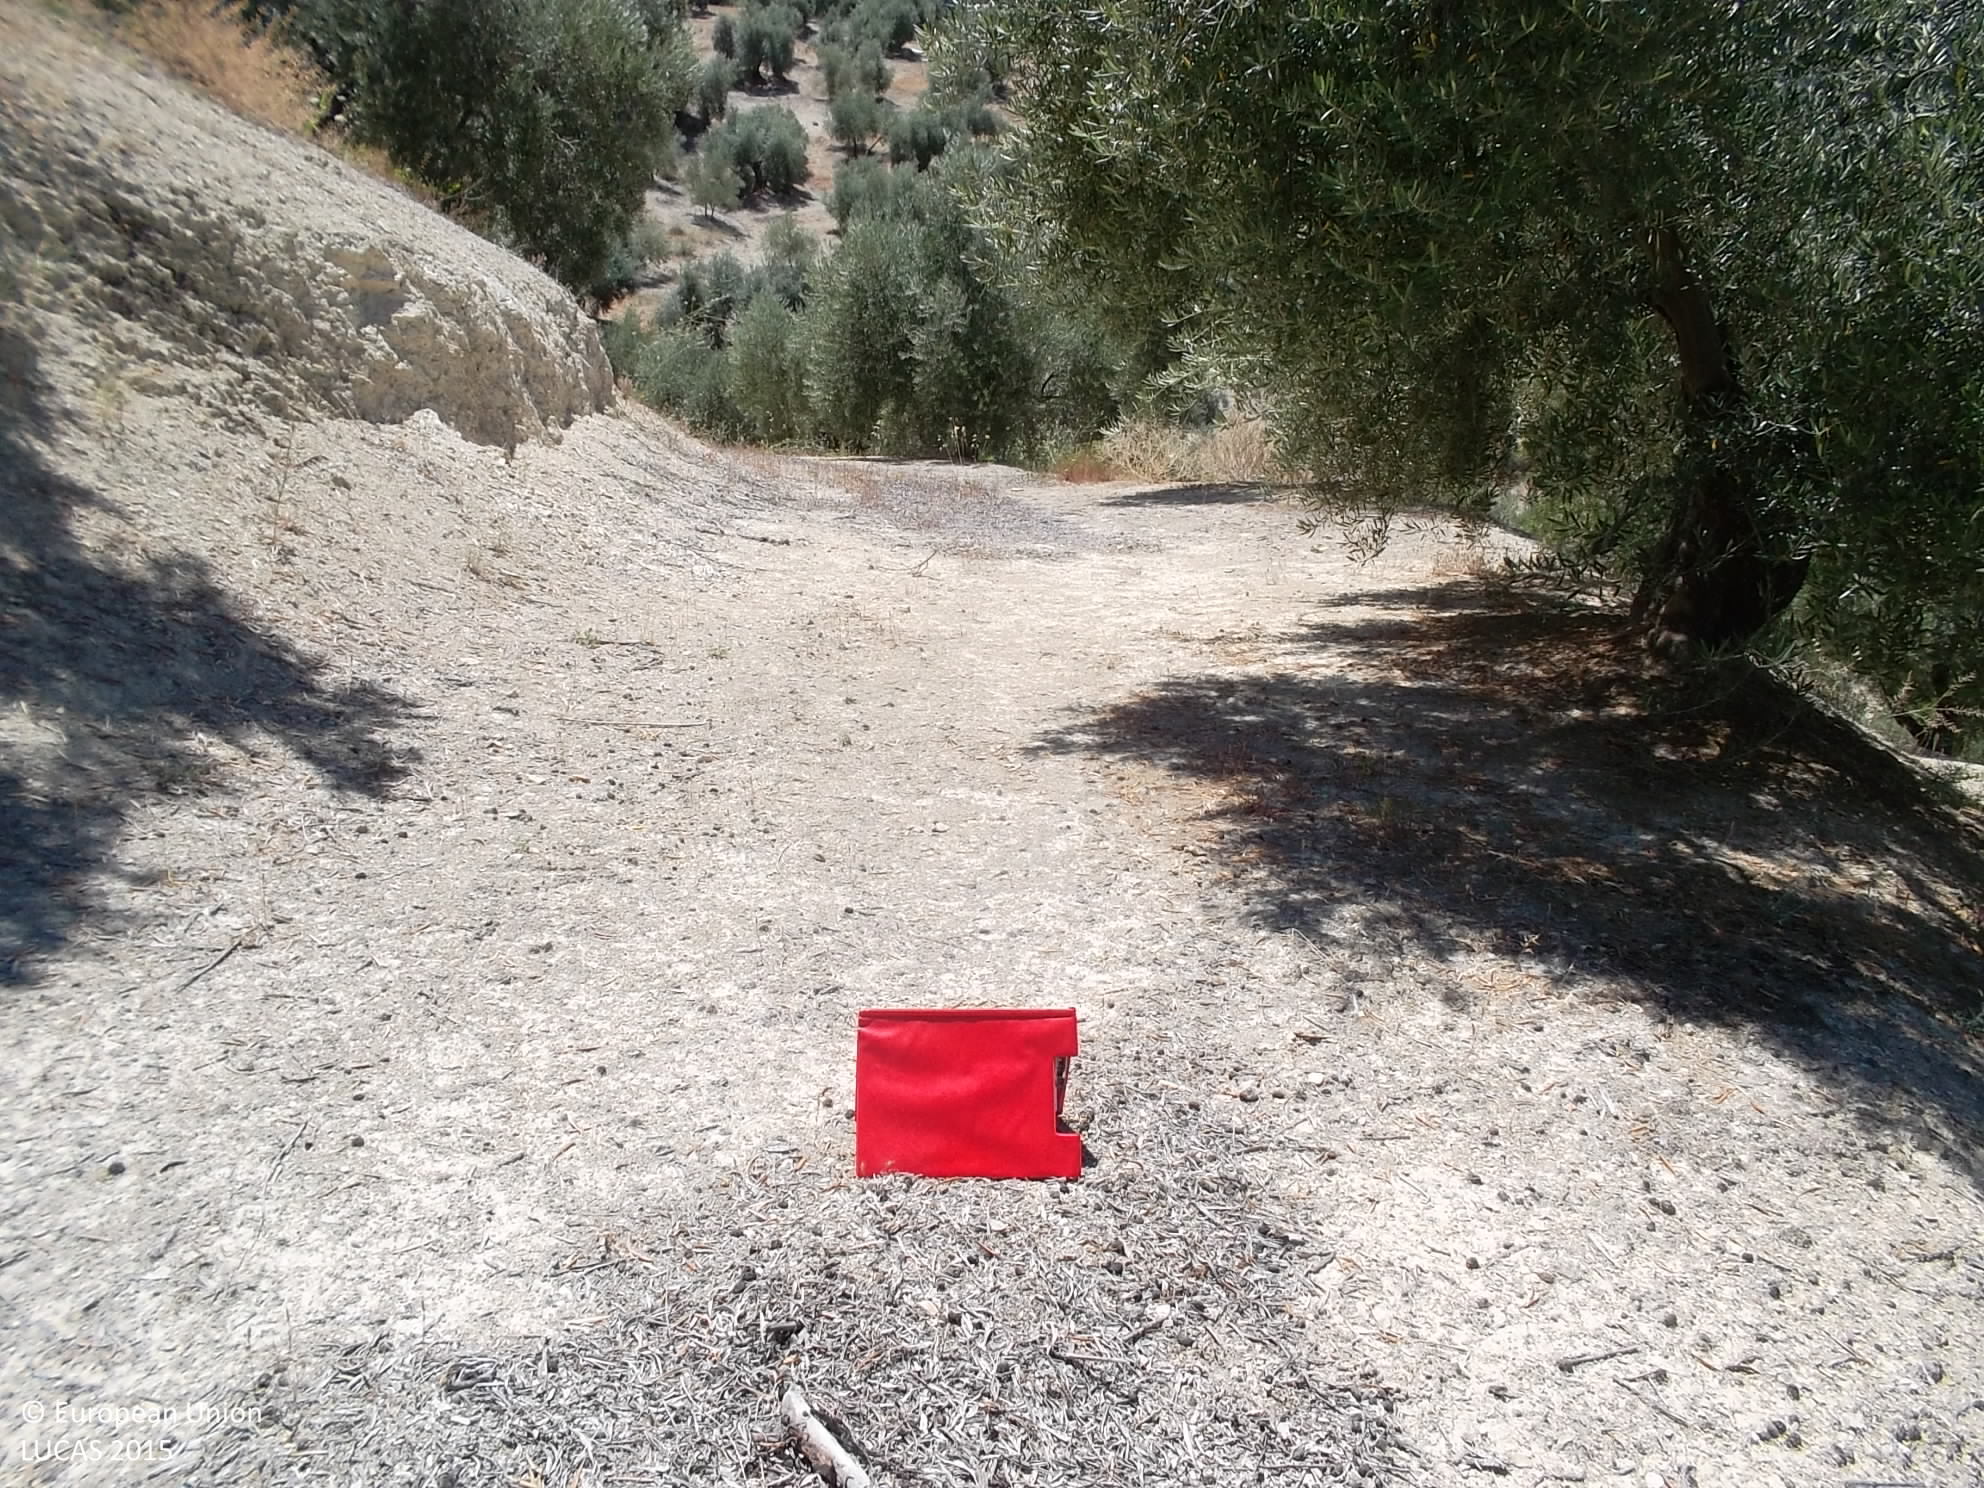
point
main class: Cropland
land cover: Olive groves
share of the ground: 50 - 75 %
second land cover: Other bare soil
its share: > 75 %
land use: Agriculture (excluding fallow land and kitchen gardens)
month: June
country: ES
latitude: 37.9361
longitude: -2.9777
